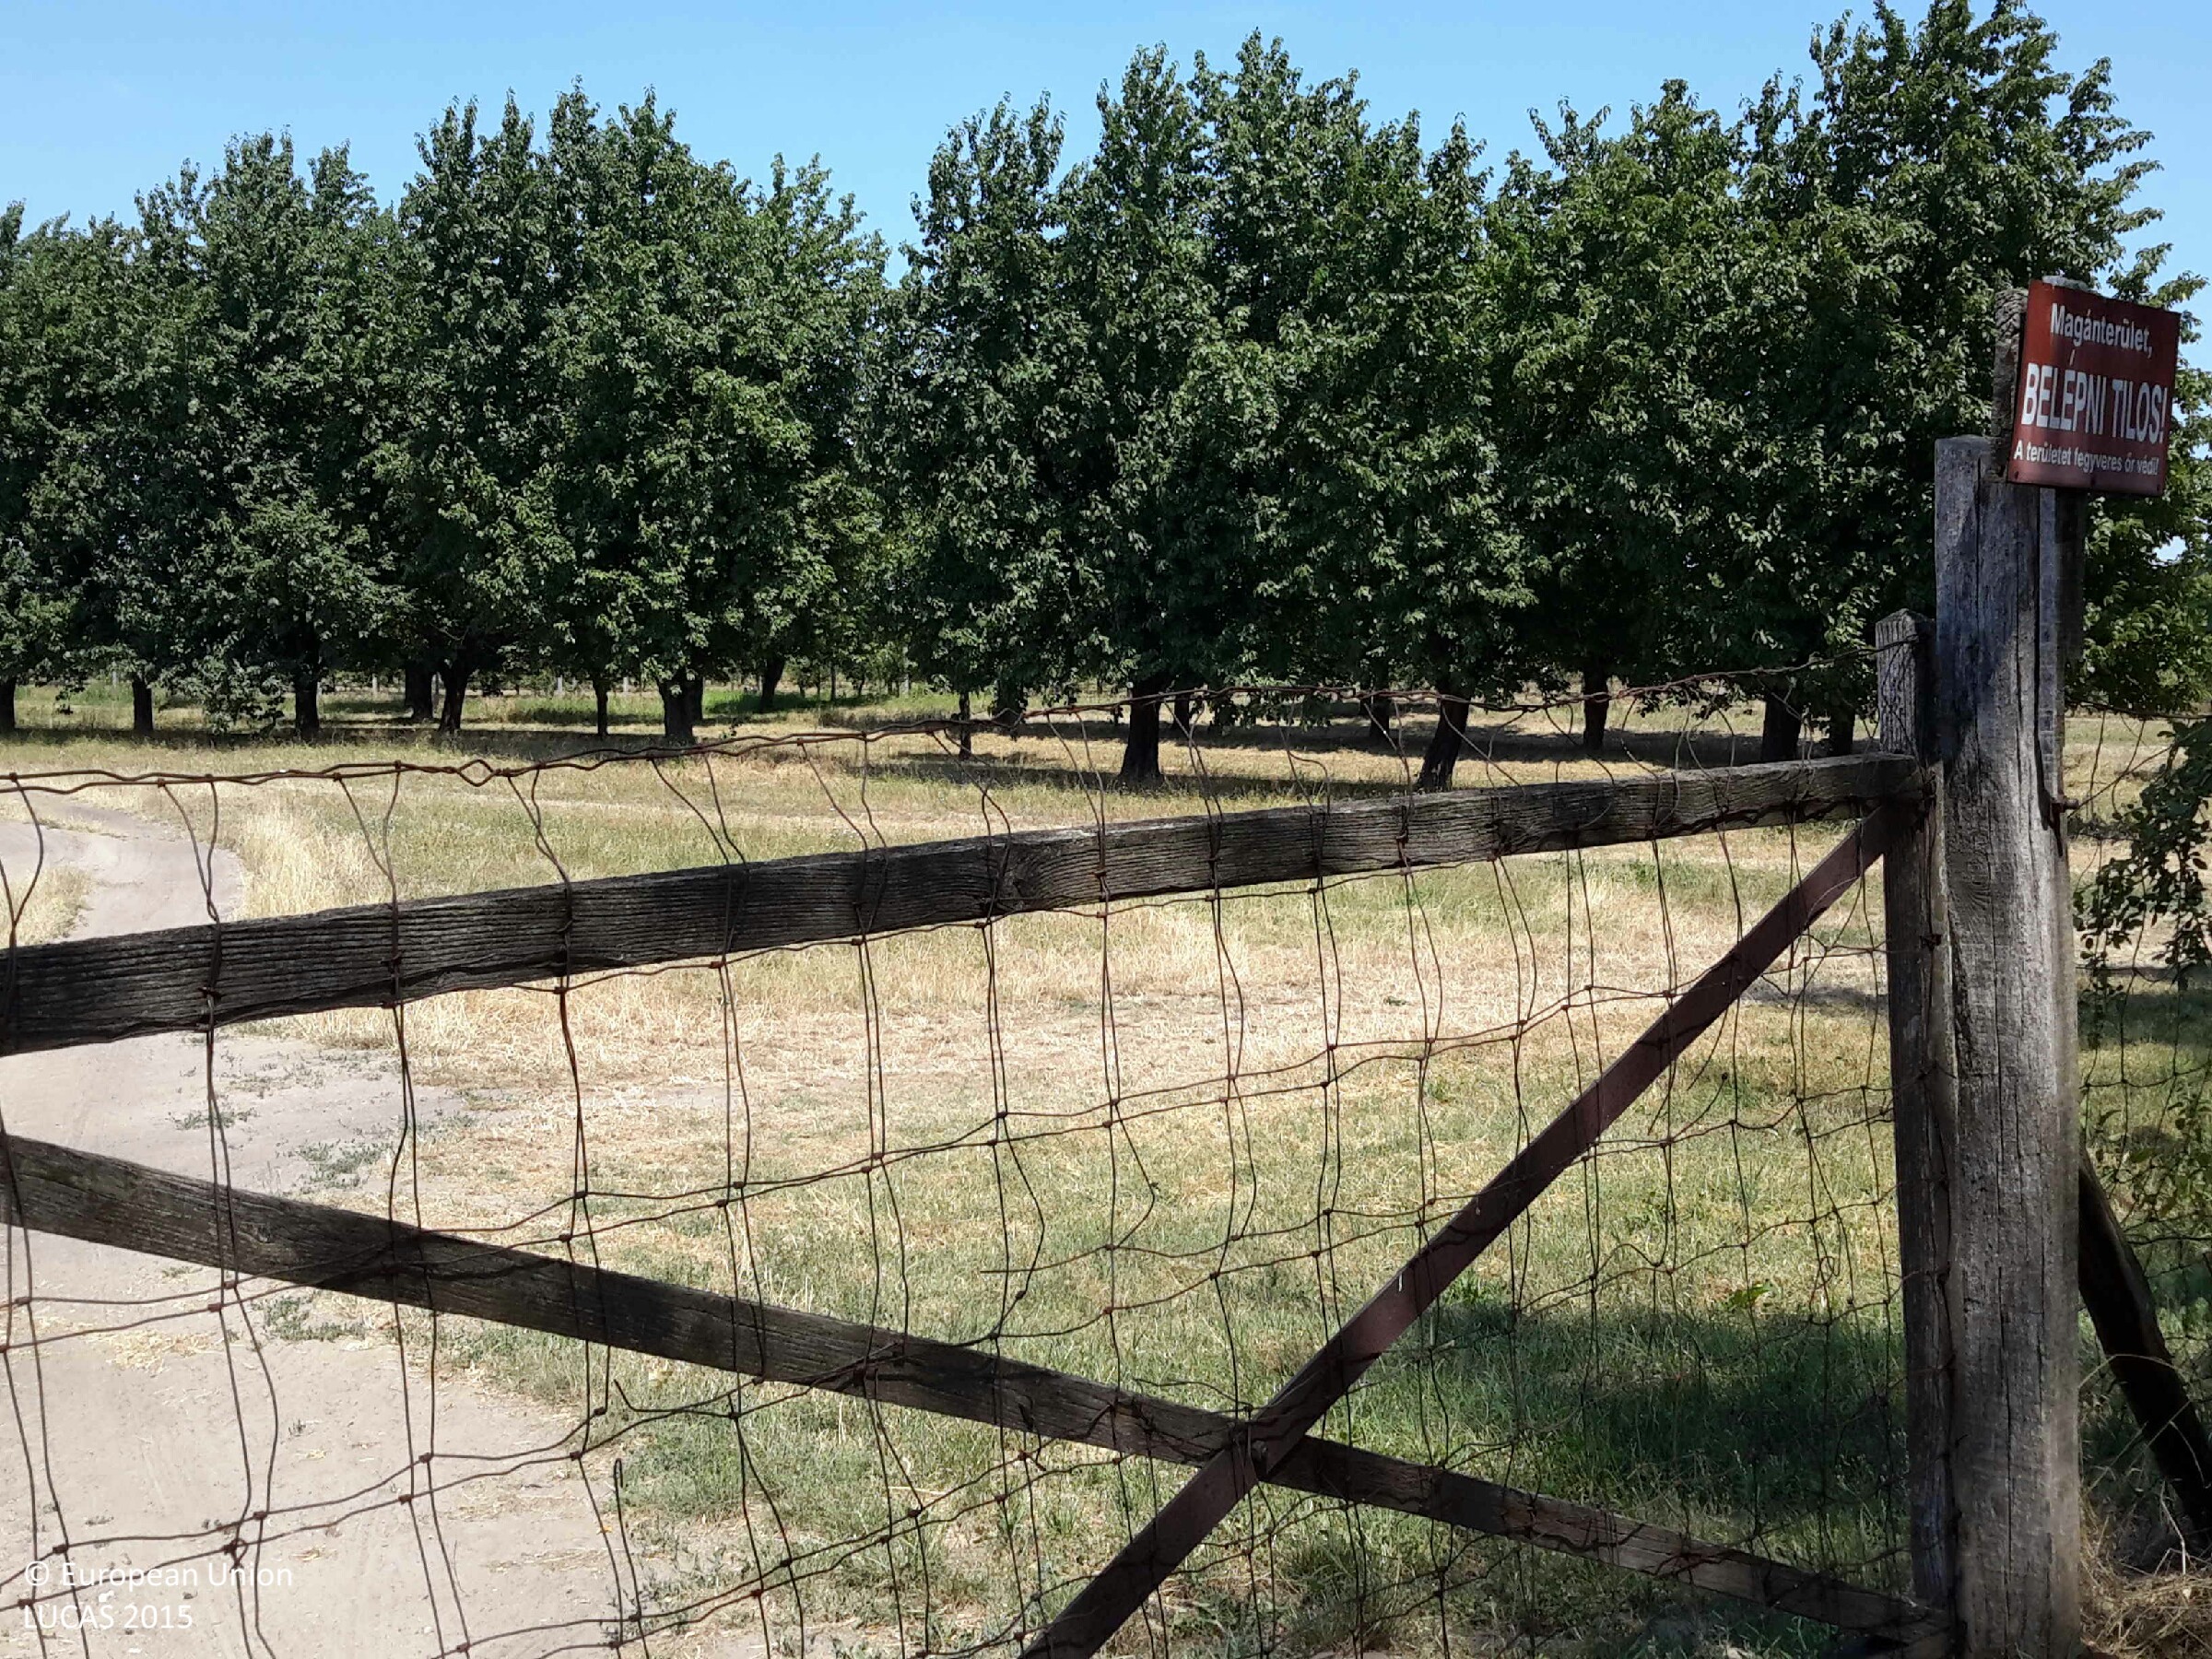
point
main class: Cropland
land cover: Permanent crops (only in case pi)
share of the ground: > 75 %
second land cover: Grassland without tree/shrub cover
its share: 50 - 75 %
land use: Agriculture (excluding fallow land and kitchen gardens)
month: July
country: HU
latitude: 47.4016
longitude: 17.8406
